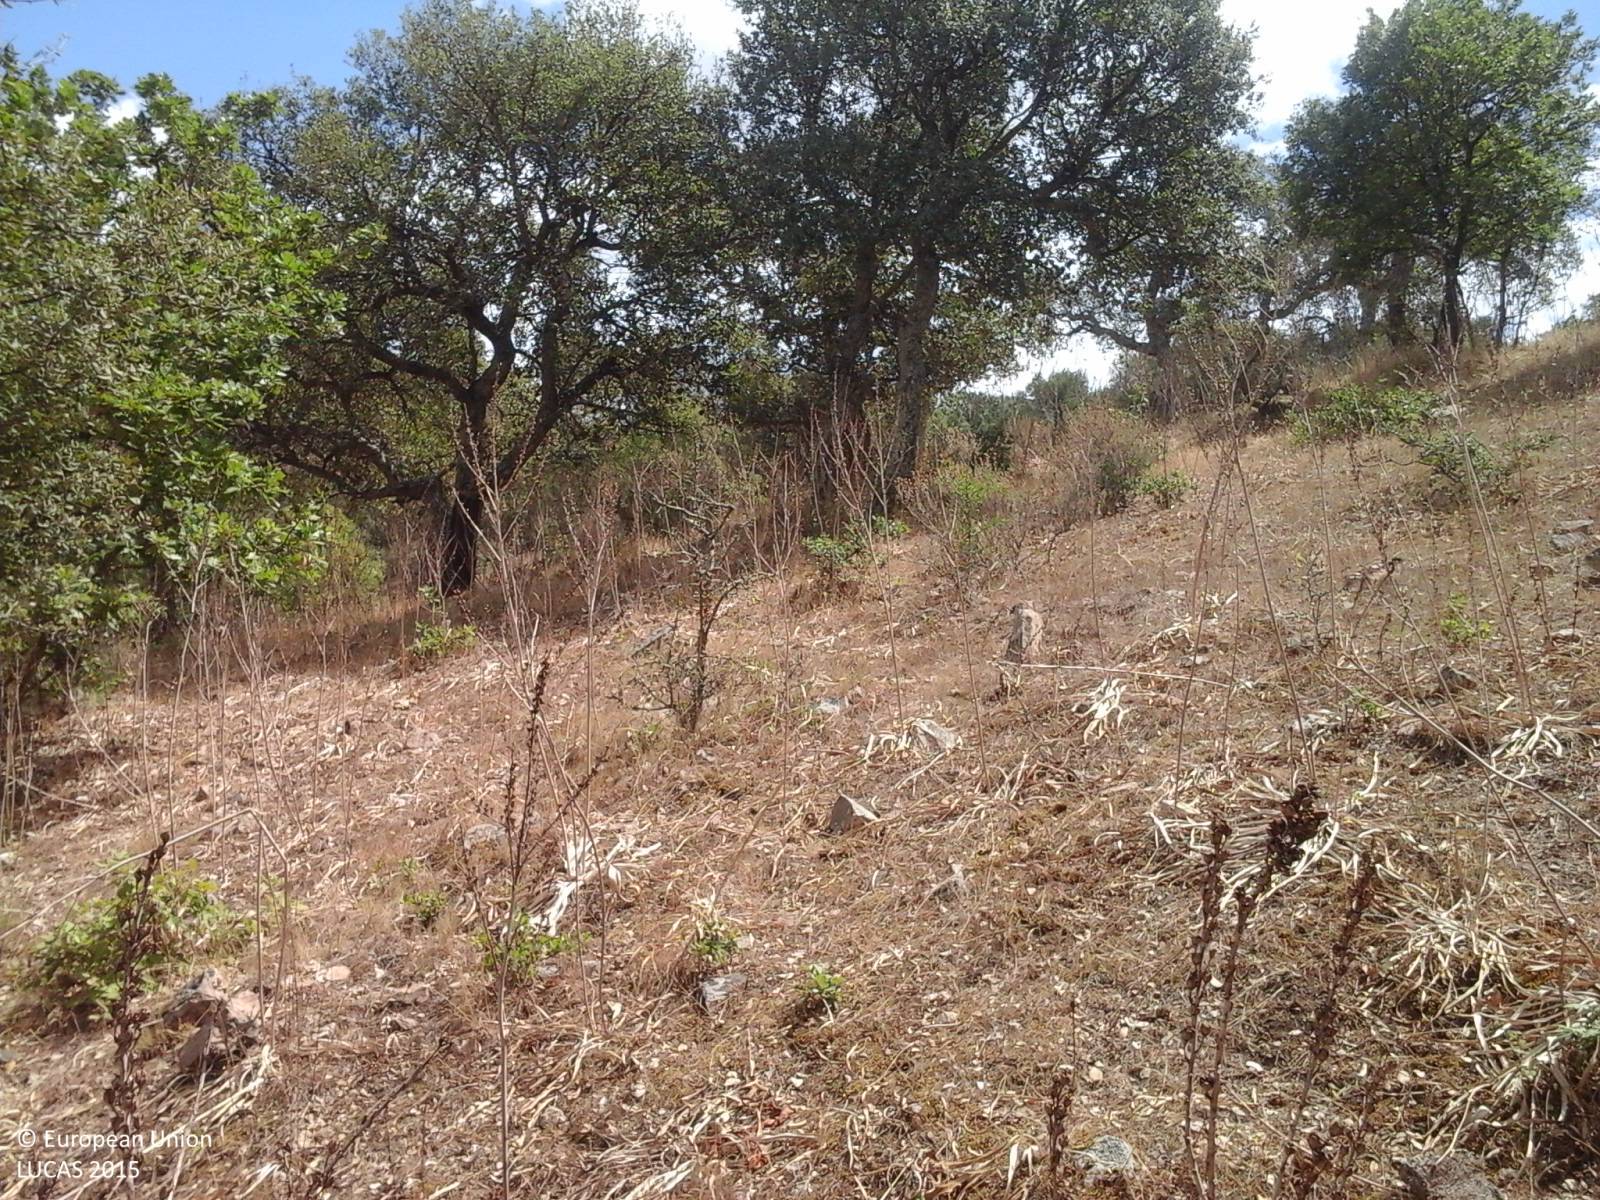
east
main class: Woodland
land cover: Broadleaved woodland
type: broadleaved evergreen forest
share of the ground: > 75 %
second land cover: Grassland without tree/shrub cover
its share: > 75 %
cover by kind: herbaceous plants 90 %, broadleaved forest trees 10 %
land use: Forestry
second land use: Agriculture (excluding fallow land and kitchen gardens)
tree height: > 5 m
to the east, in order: Broadleaved woodland; Grassland without tree/shrub cover; Tracks; Broadleaved woodland; Tracks; Grassland with sparse tree/shrub cover; Fences; Dry stone walls; Tracks; Grassland without tree/shrub cover; Paved roads, cycling and walking lanes; Grass margins; Shrubland without tree cover; Fences; Broadleaved woodland; Shrubland without tree cover
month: August
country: IT
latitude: 40.6249
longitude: 9.0707
